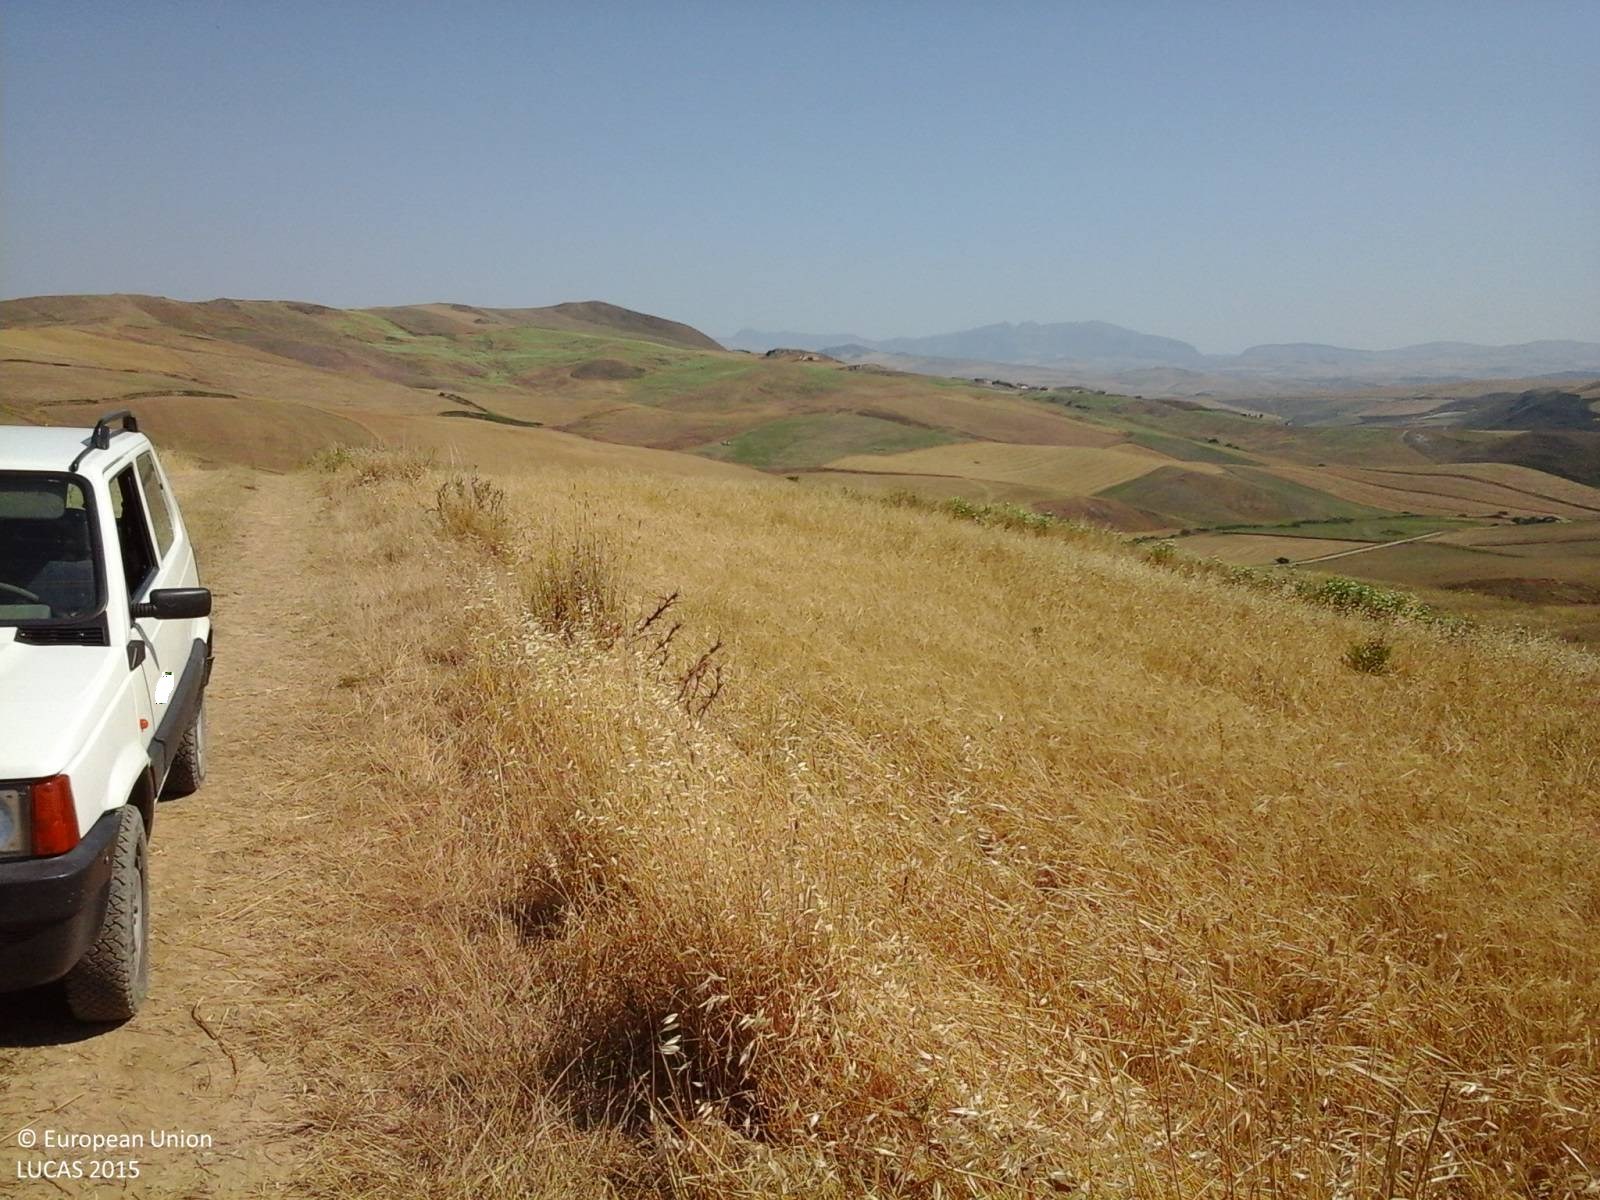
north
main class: Cropland
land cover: Barley
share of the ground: > 75 %
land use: Agriculture (excluding fallow land and kitchen gardens)
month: July
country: IT
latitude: 37.7675
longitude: 13.1666
